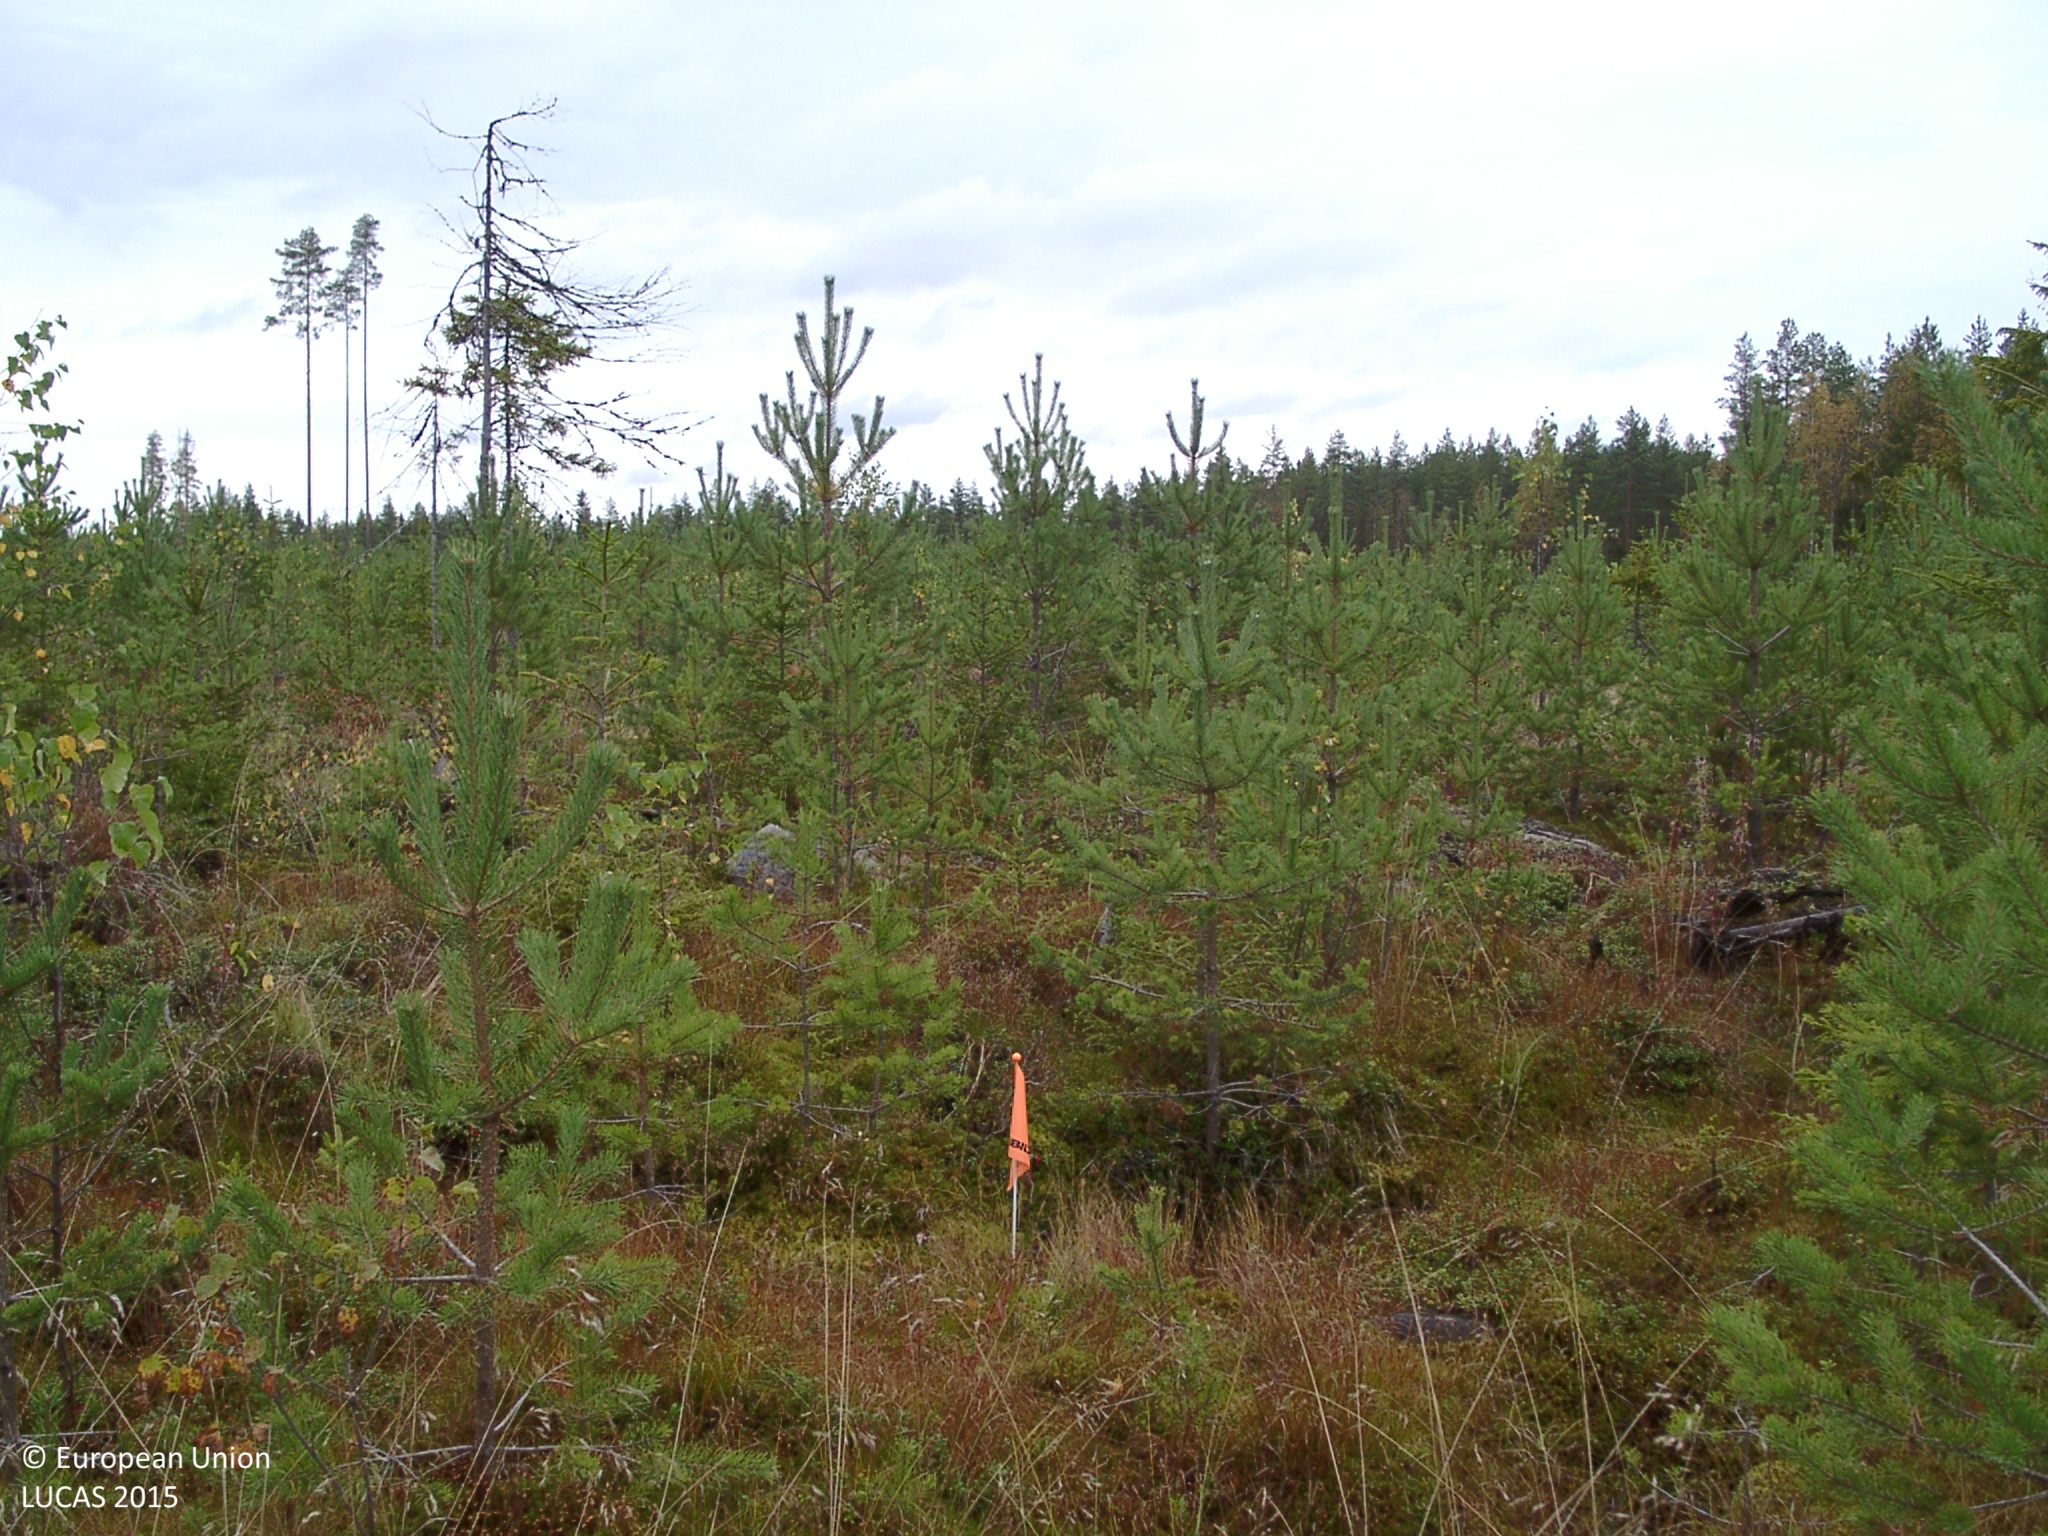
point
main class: Woodland
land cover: Pine dominated coniferous woodland
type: boreal forest
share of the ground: 10 - 25 %
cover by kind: lichens and mosses 30 %, shrubs 25 %, herbaceous plants 25 %, coniferous forest trees 20 %
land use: Forestry
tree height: < 5 m
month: September
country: FI
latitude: 62.8199
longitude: 25.4727
